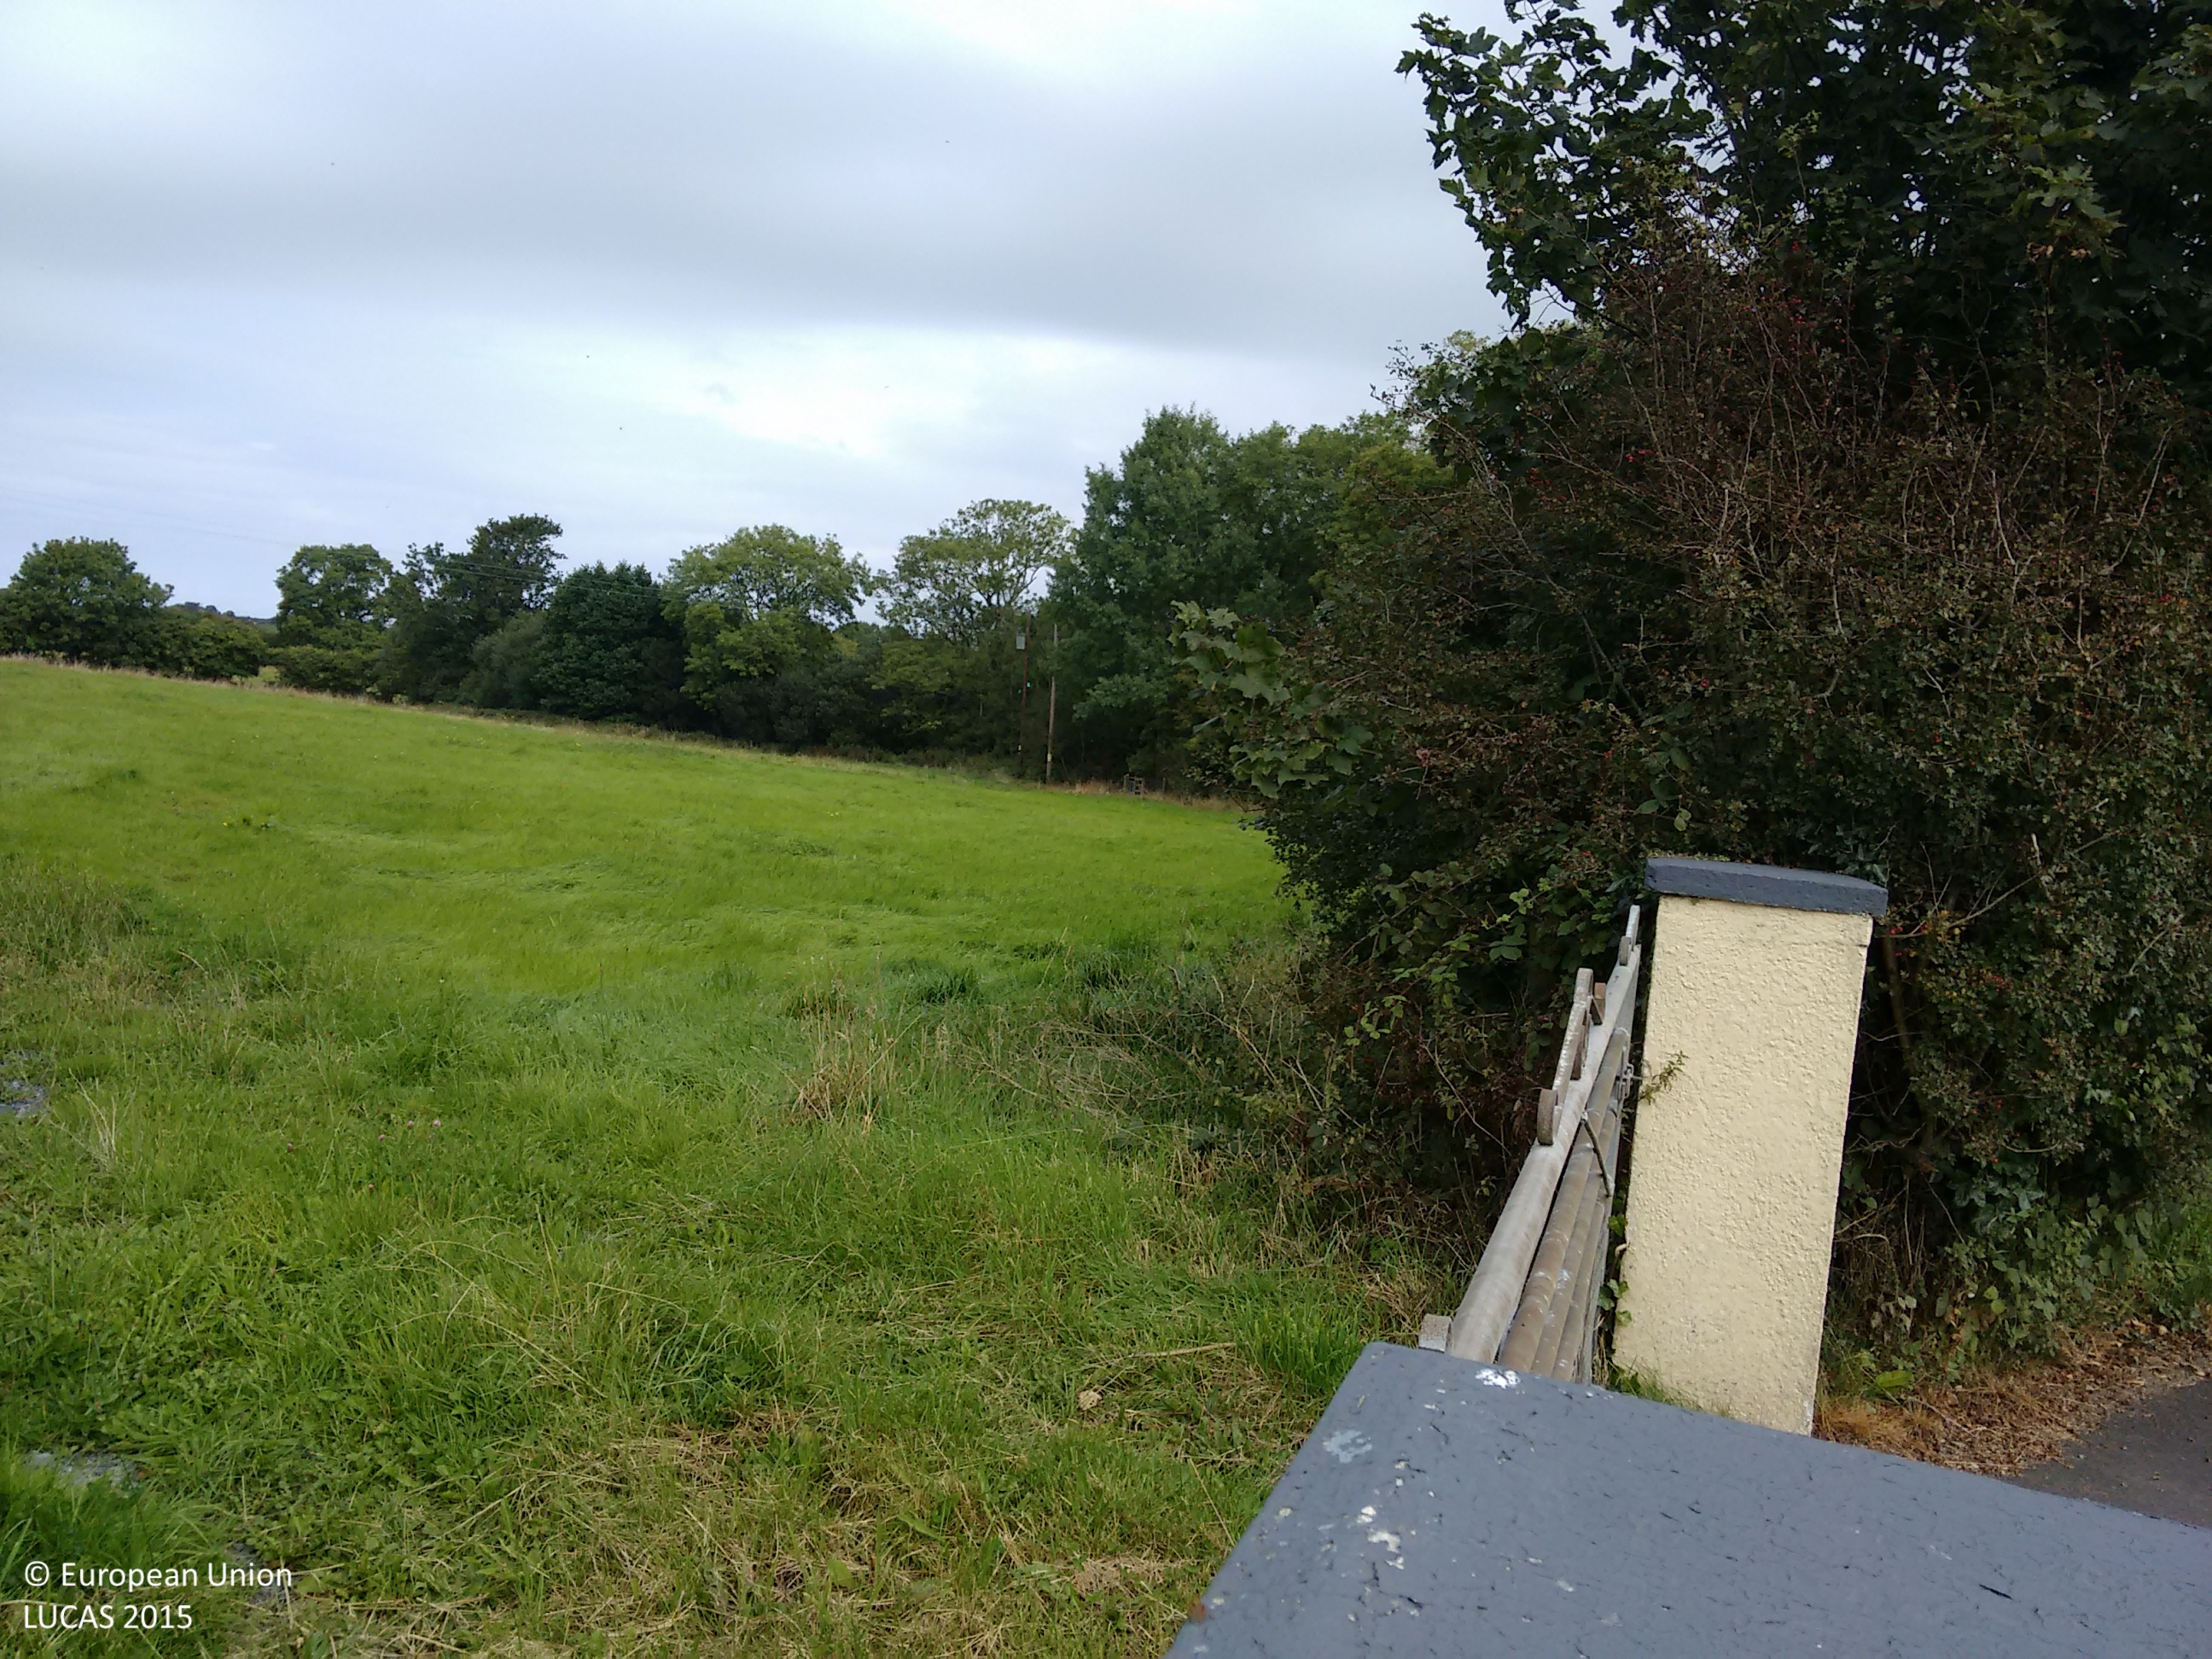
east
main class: Grassland
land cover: Grassland without tree/shrub cover
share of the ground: > 75 %
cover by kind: herbaceous plants 100 %
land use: Agriculture (excluding fallow land and kitchen gardens)
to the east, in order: Grassland without tree/shrub cover; Electric lines; Grassland without tree/shrub cover; Fences; Broadleaved woodland; Rivers and streams; Broadleaved woodland; Fences; Grassland without tree/shrub cover; Fences; Grassland without tree/shrub cover; Fences; Grassland without tree/shrub cover; Fences; Managed hedges; Artificial constructions in urban areas; Abandoned hedges; Grassland without tree/shrub cover
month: September
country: GB
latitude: 52.1108
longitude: -4.5778
